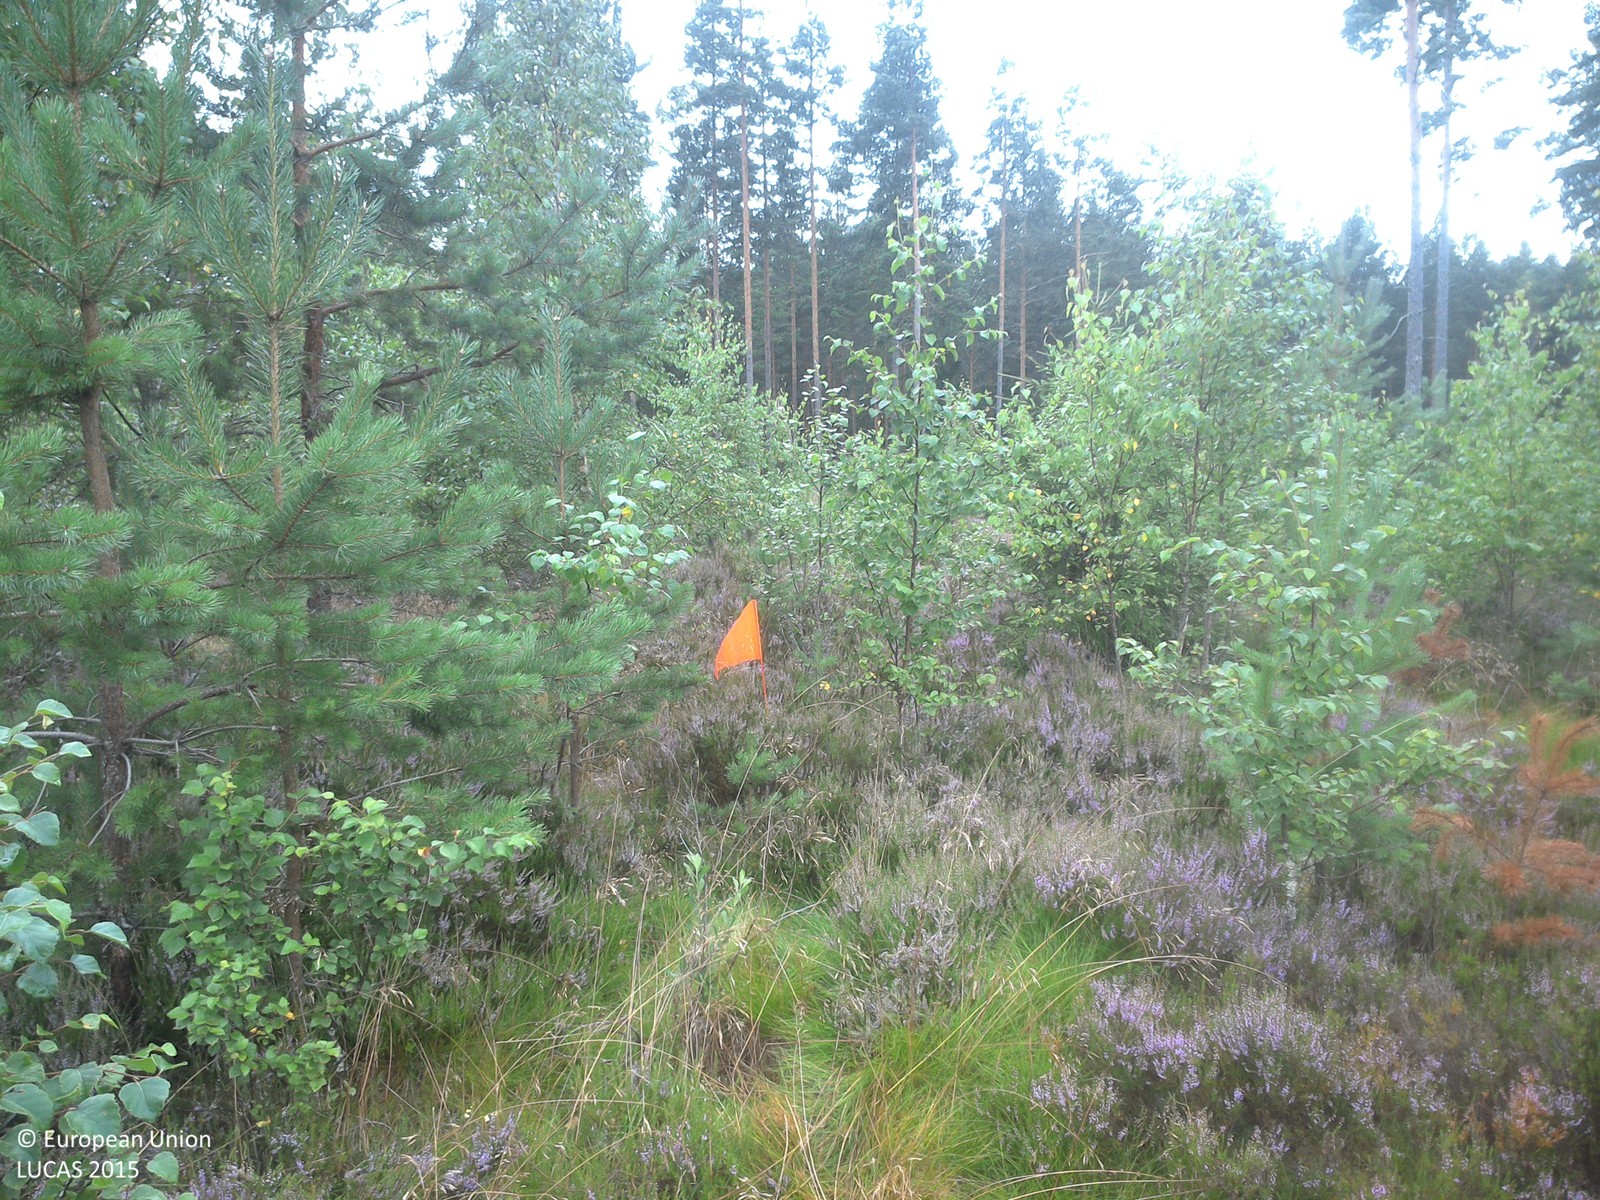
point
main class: Woodland
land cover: Pine dominated mixed woodland
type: boreal forest
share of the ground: 25 - 50 %
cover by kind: herbaceous plants 40 %, coniferous forest trees 25 %, shrubs 20 %, broadleaved forest trees 10 %, lichens and mosses 5 %
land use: Forestry
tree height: < 5 m
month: August
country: SE
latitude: 57.7992
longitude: 15.5316
